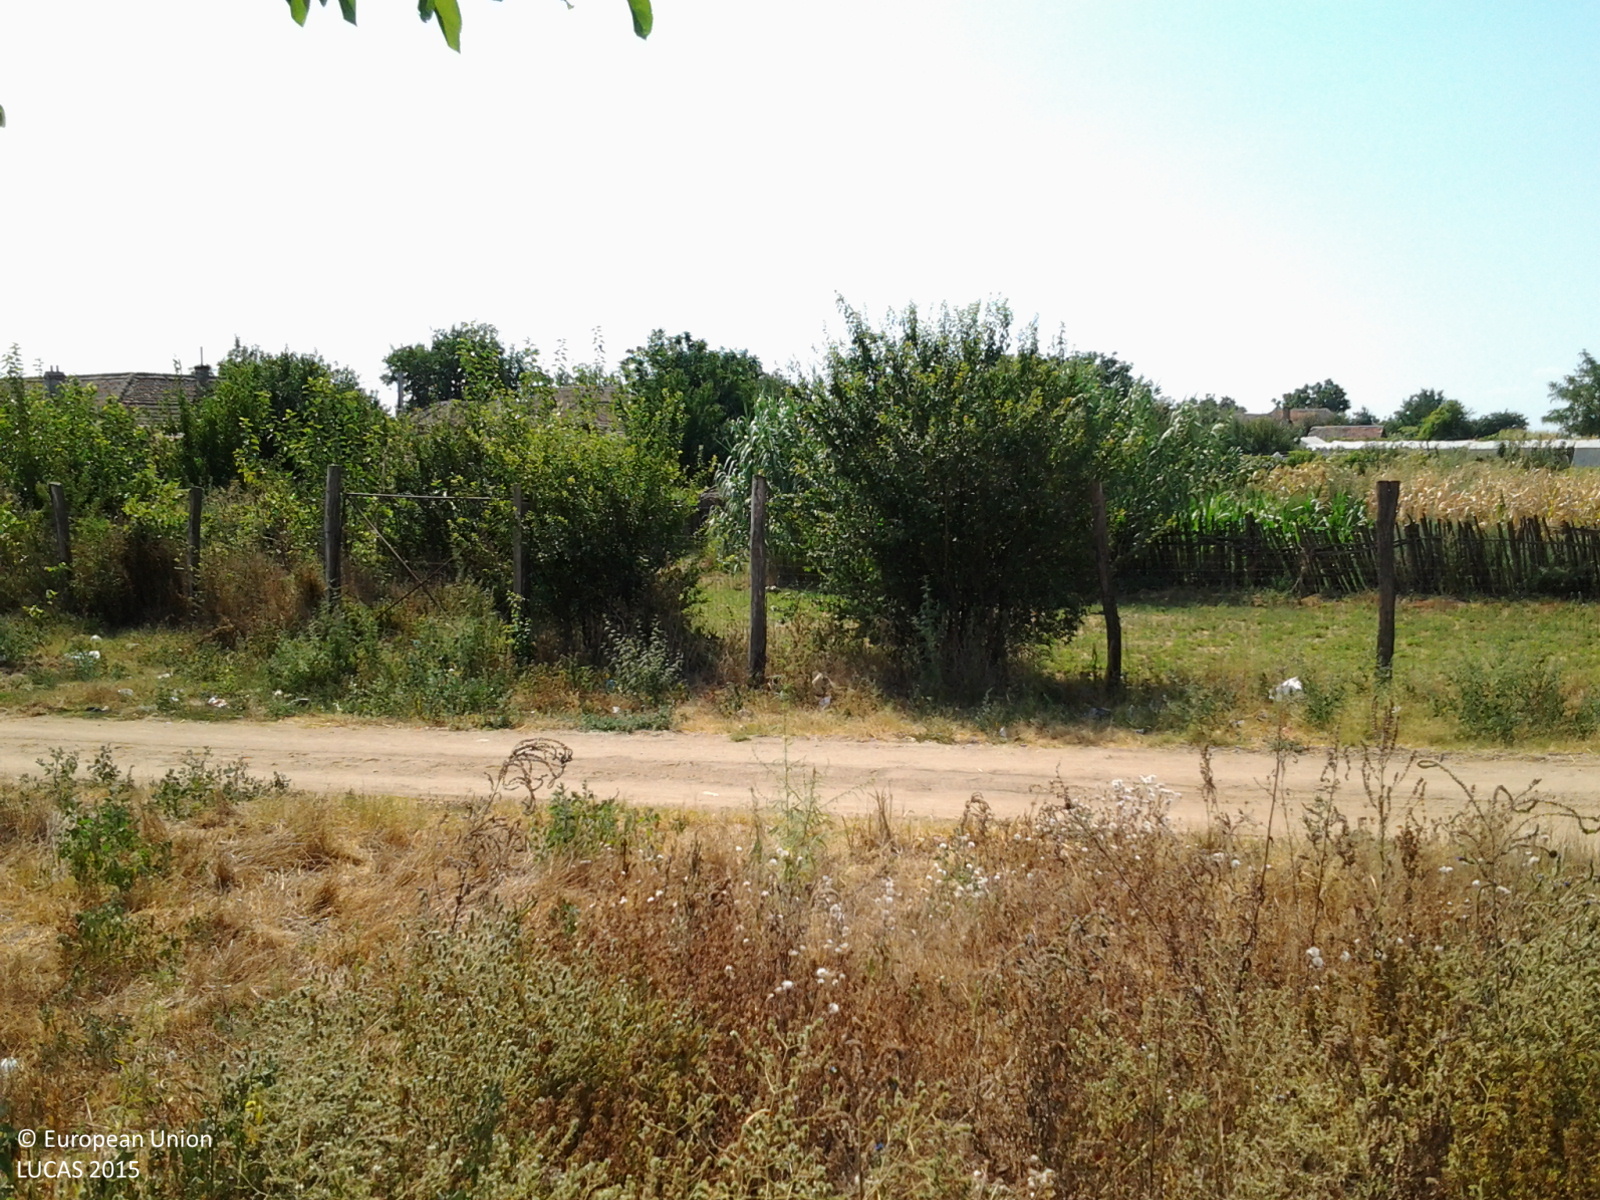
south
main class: Grassland
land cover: Spontaneously vegetated surfaces
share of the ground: > 75 %
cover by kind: herbaceous plants 100 %
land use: Semi-natural and natural areas not in use
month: August
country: RO
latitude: 43.9356
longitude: 22.9586
